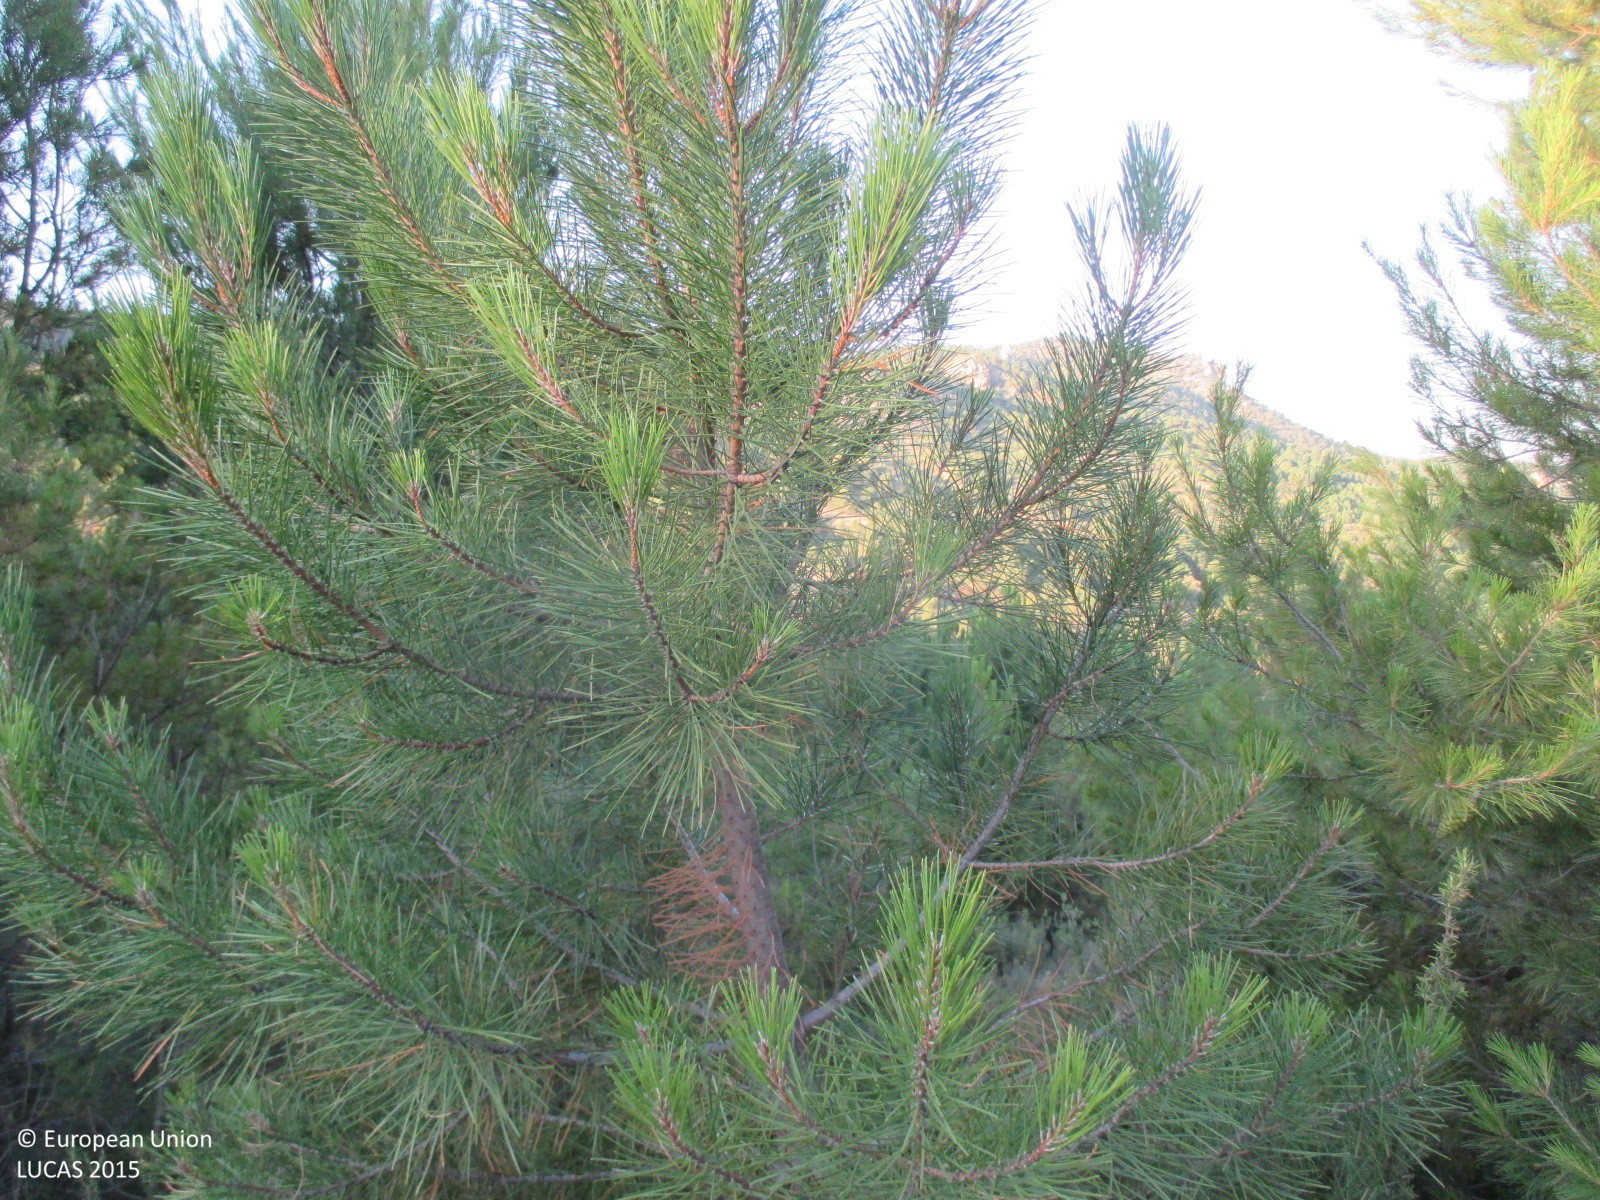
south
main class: Woodland
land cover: Pine dominated coniferous woodland
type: coniferous forest of the mediterranean region
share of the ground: 25 - 50 %
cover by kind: coniferous forest trees 40 %, shrubs 40 %, herbaceous plants 20 %
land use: Forestry
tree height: > 5 m
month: July
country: ES
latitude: 38.3447
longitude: -2.3875
